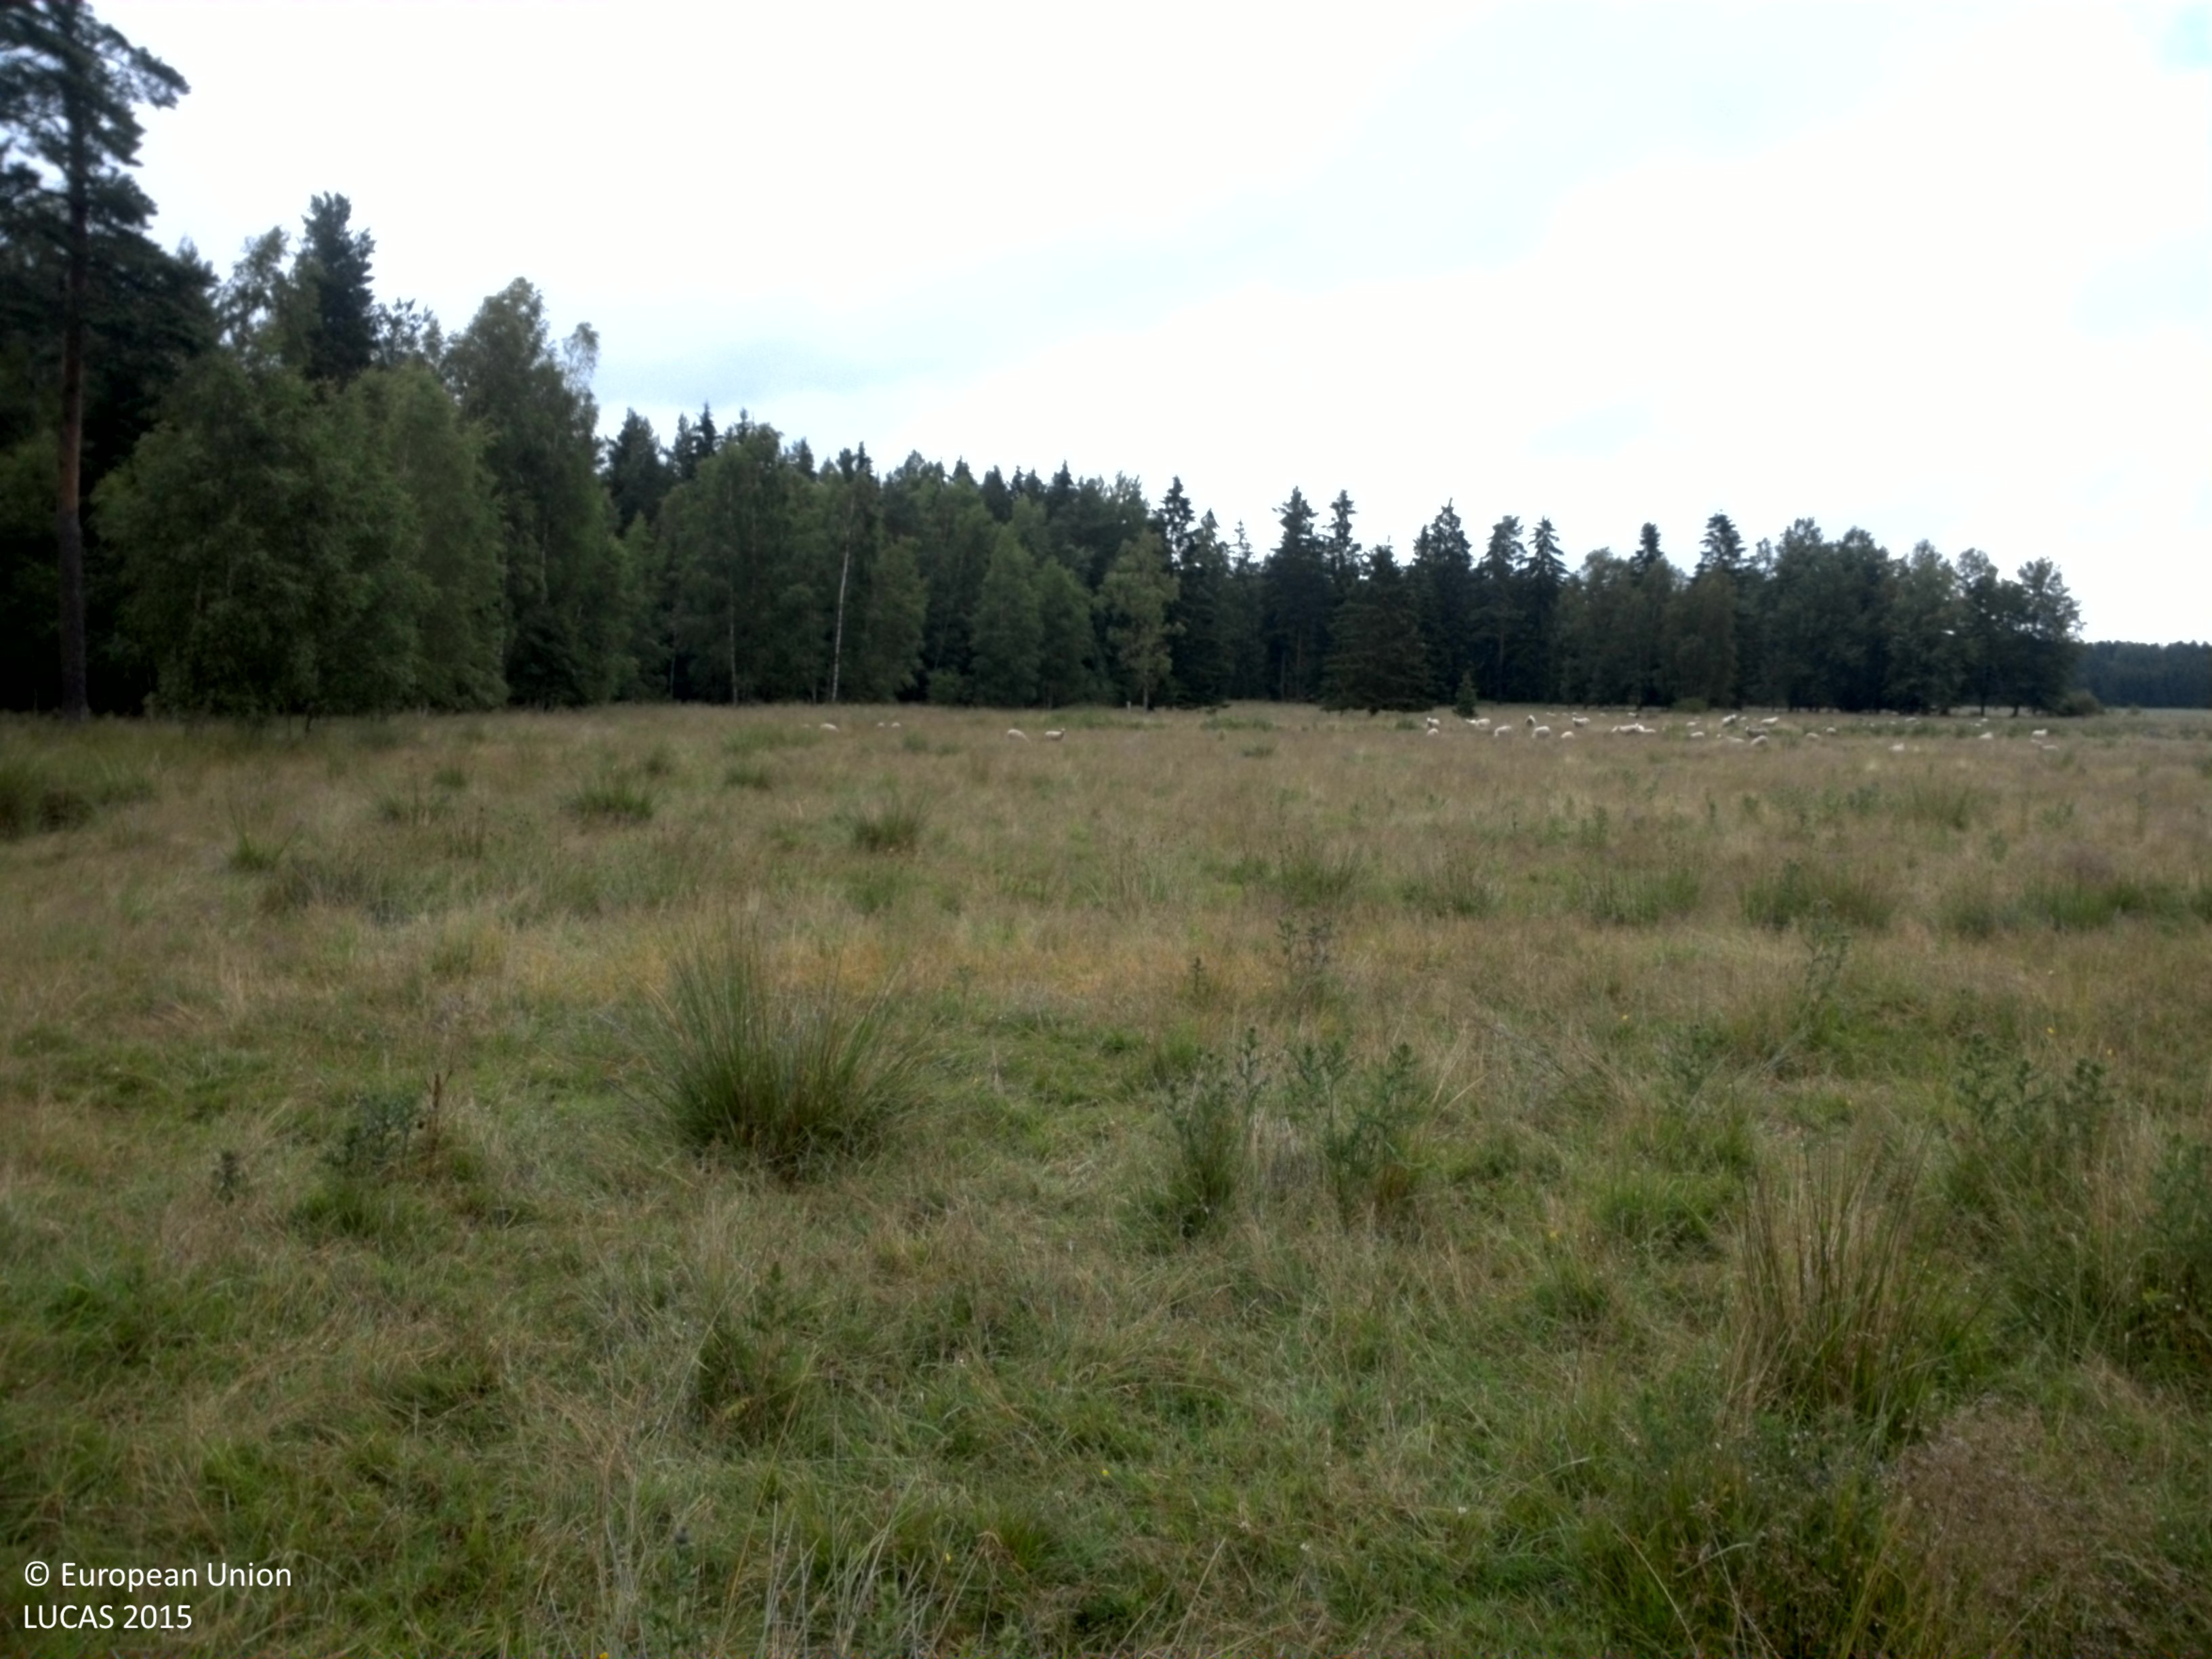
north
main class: Grassland
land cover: Grassland without tree/shrub cover
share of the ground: > 75 %
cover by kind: herbaceous plants 100 %
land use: Agriculture (excluding fallow land and kitchen gardens)
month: July
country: SE
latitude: 58.1963
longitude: 13.9921
